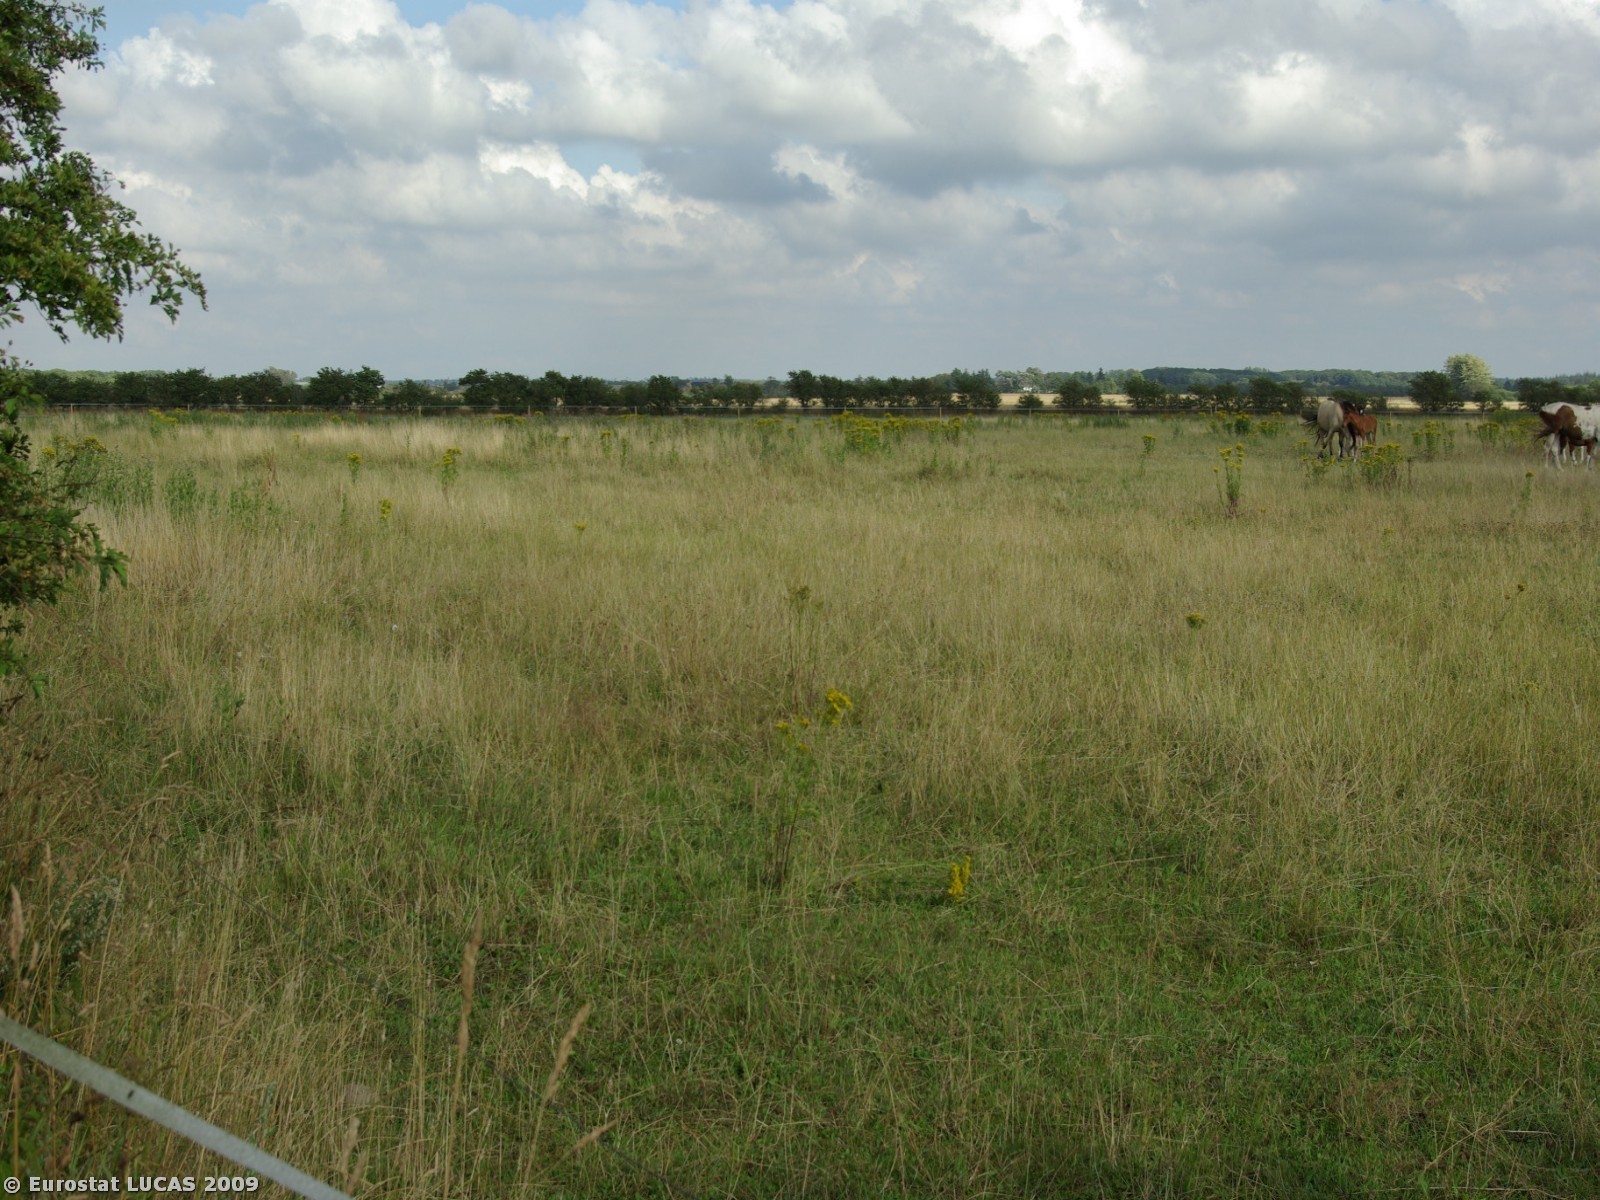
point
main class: Grassland
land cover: Grassland without tree/shrub cover
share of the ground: > 75 %
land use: Agriculture (excluding fallow land and kitchen gardens)
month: July
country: DK
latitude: 55.2119
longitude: 8.8537
